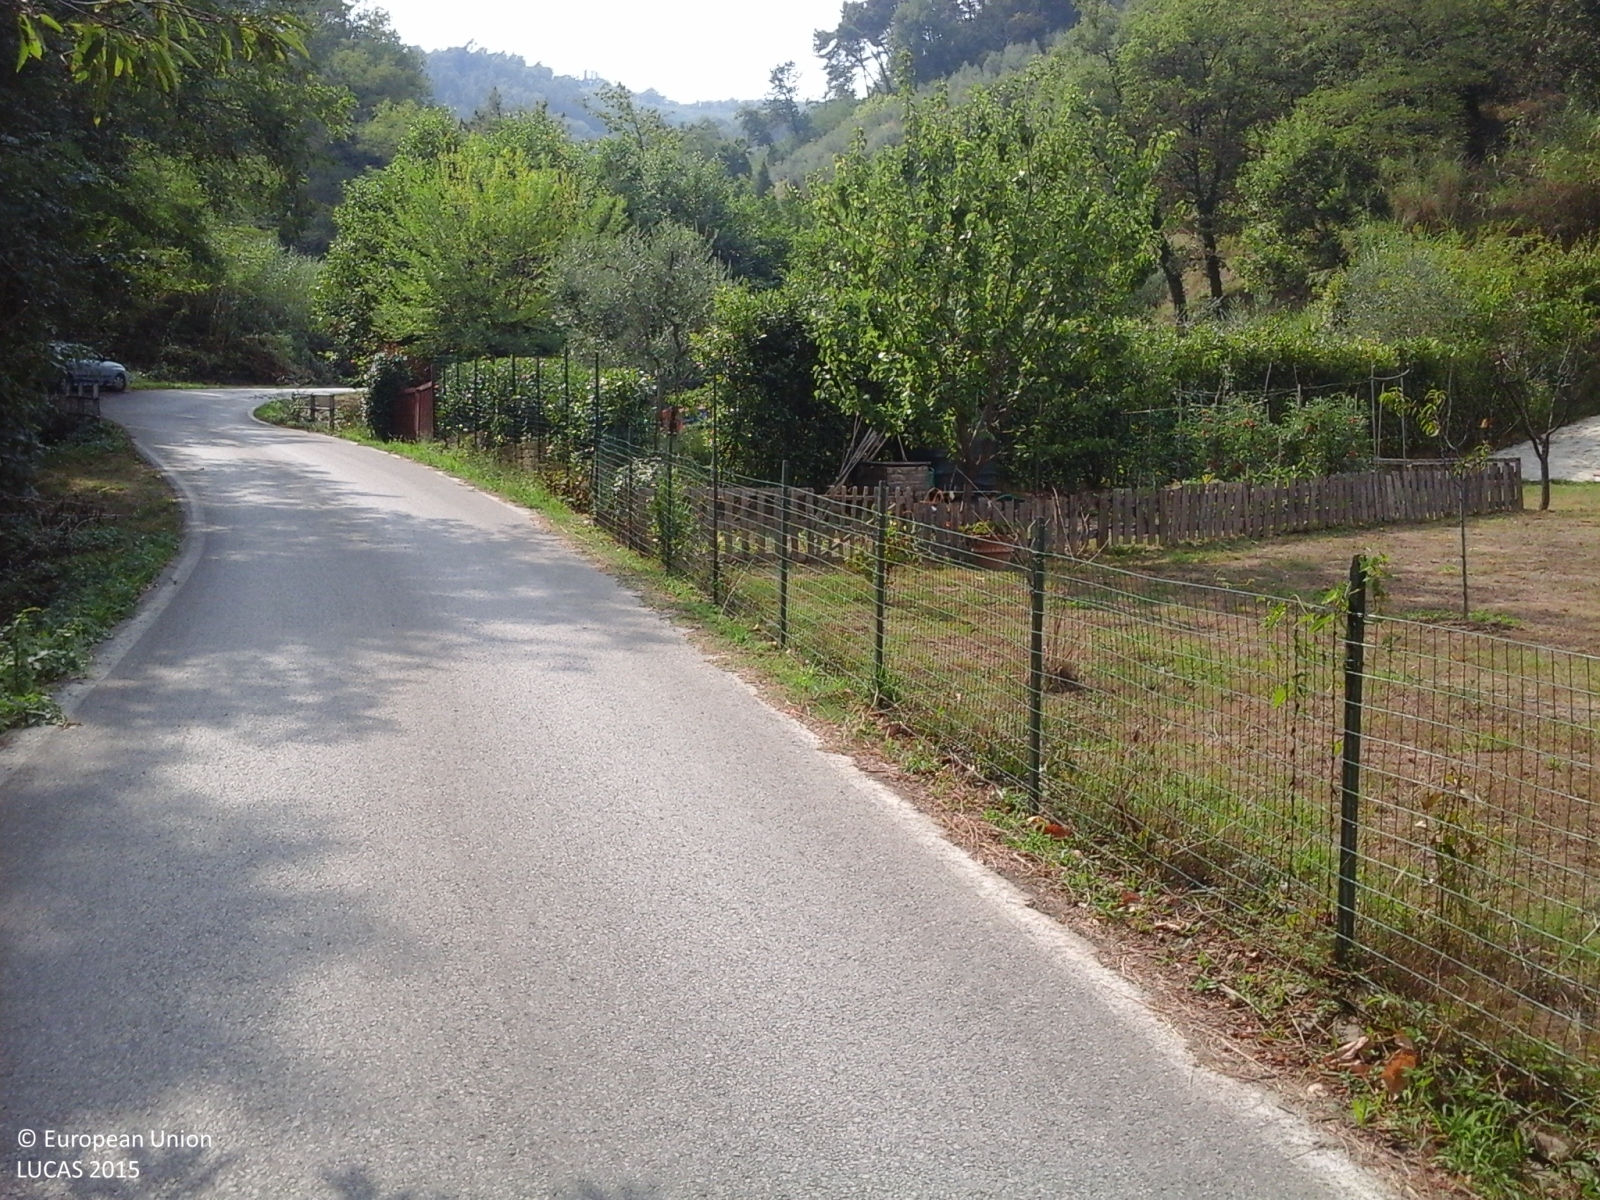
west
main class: Grassland
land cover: Grassland without tree/shrub cover
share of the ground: 50 - 75 %
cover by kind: herbaceous plants 95 %, shrubs 5 %
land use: Residential
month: August
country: IT
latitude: 43.9501
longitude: 10.8576
